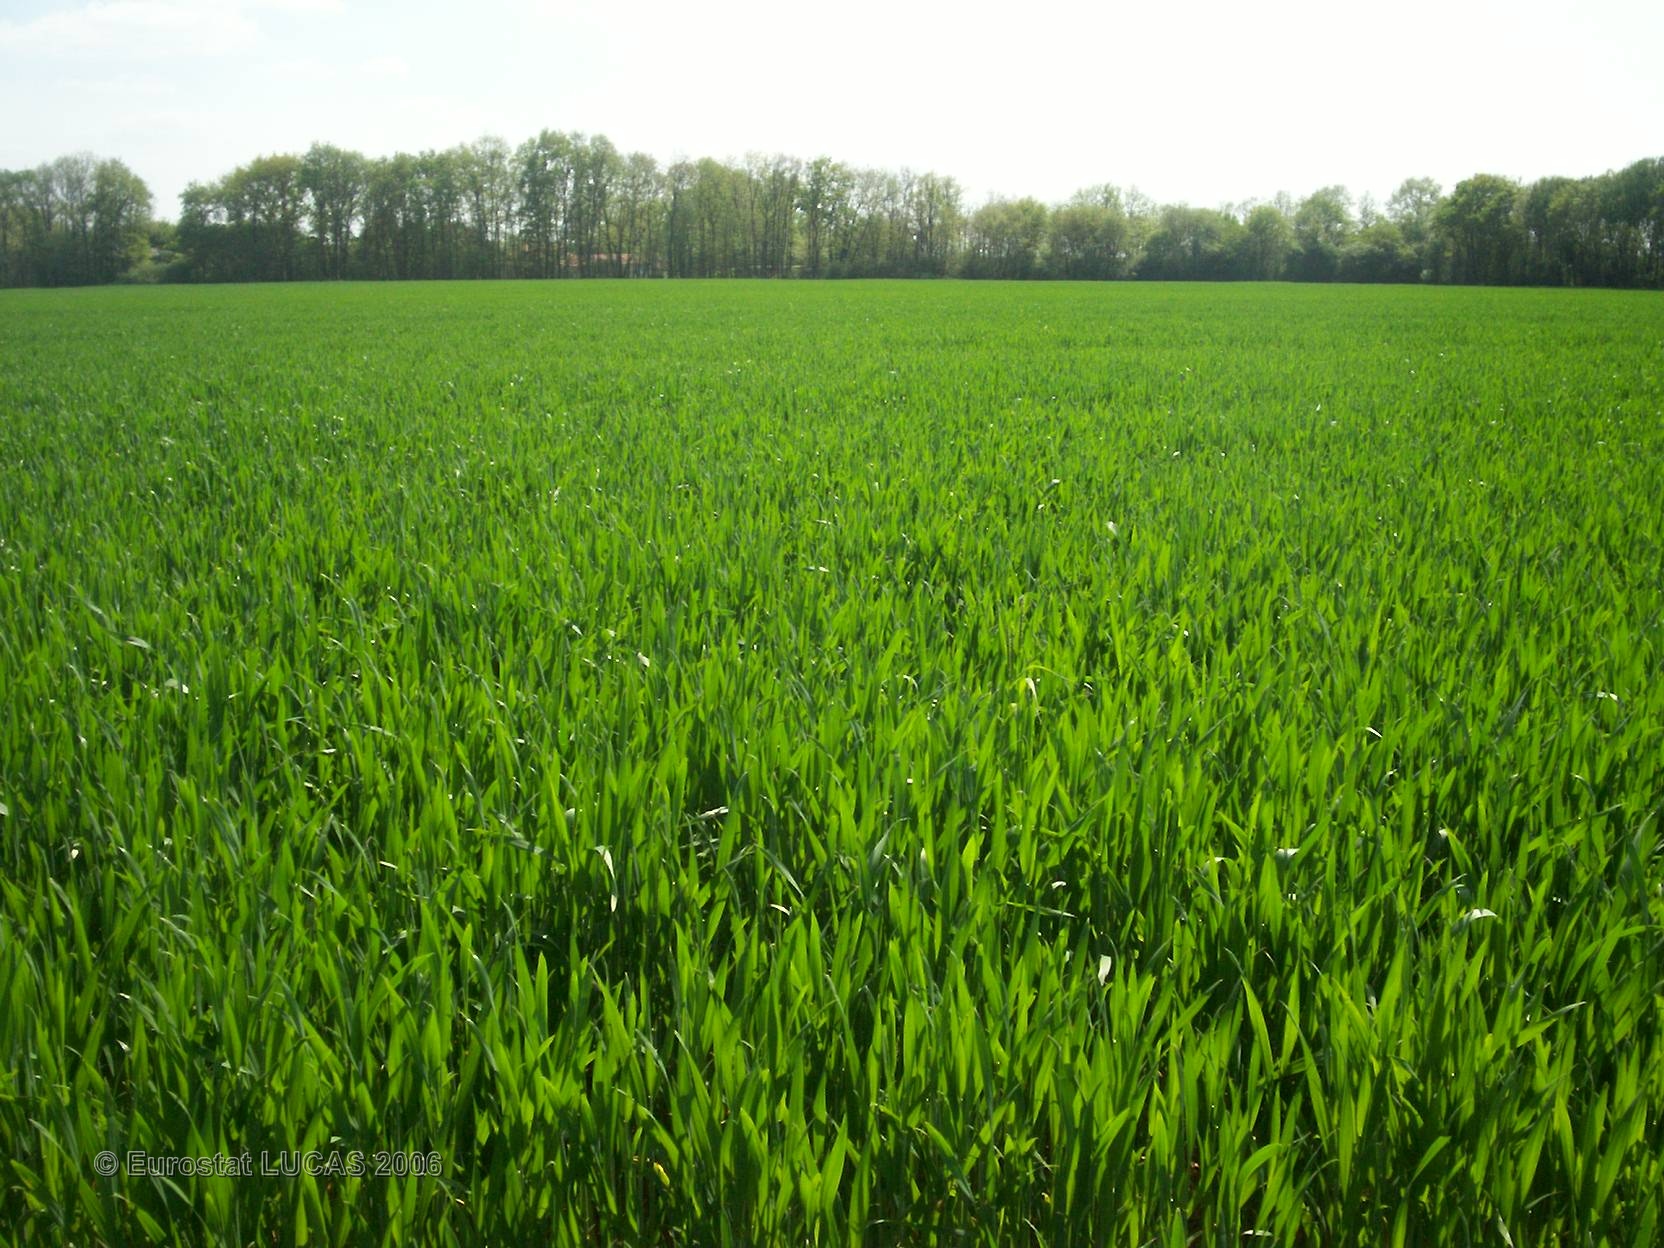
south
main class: Cropland
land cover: Common wheat
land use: Agriculture (excluding fallow land and kitchen gardens)
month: May
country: FR
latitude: 46.5061
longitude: 0.4823
